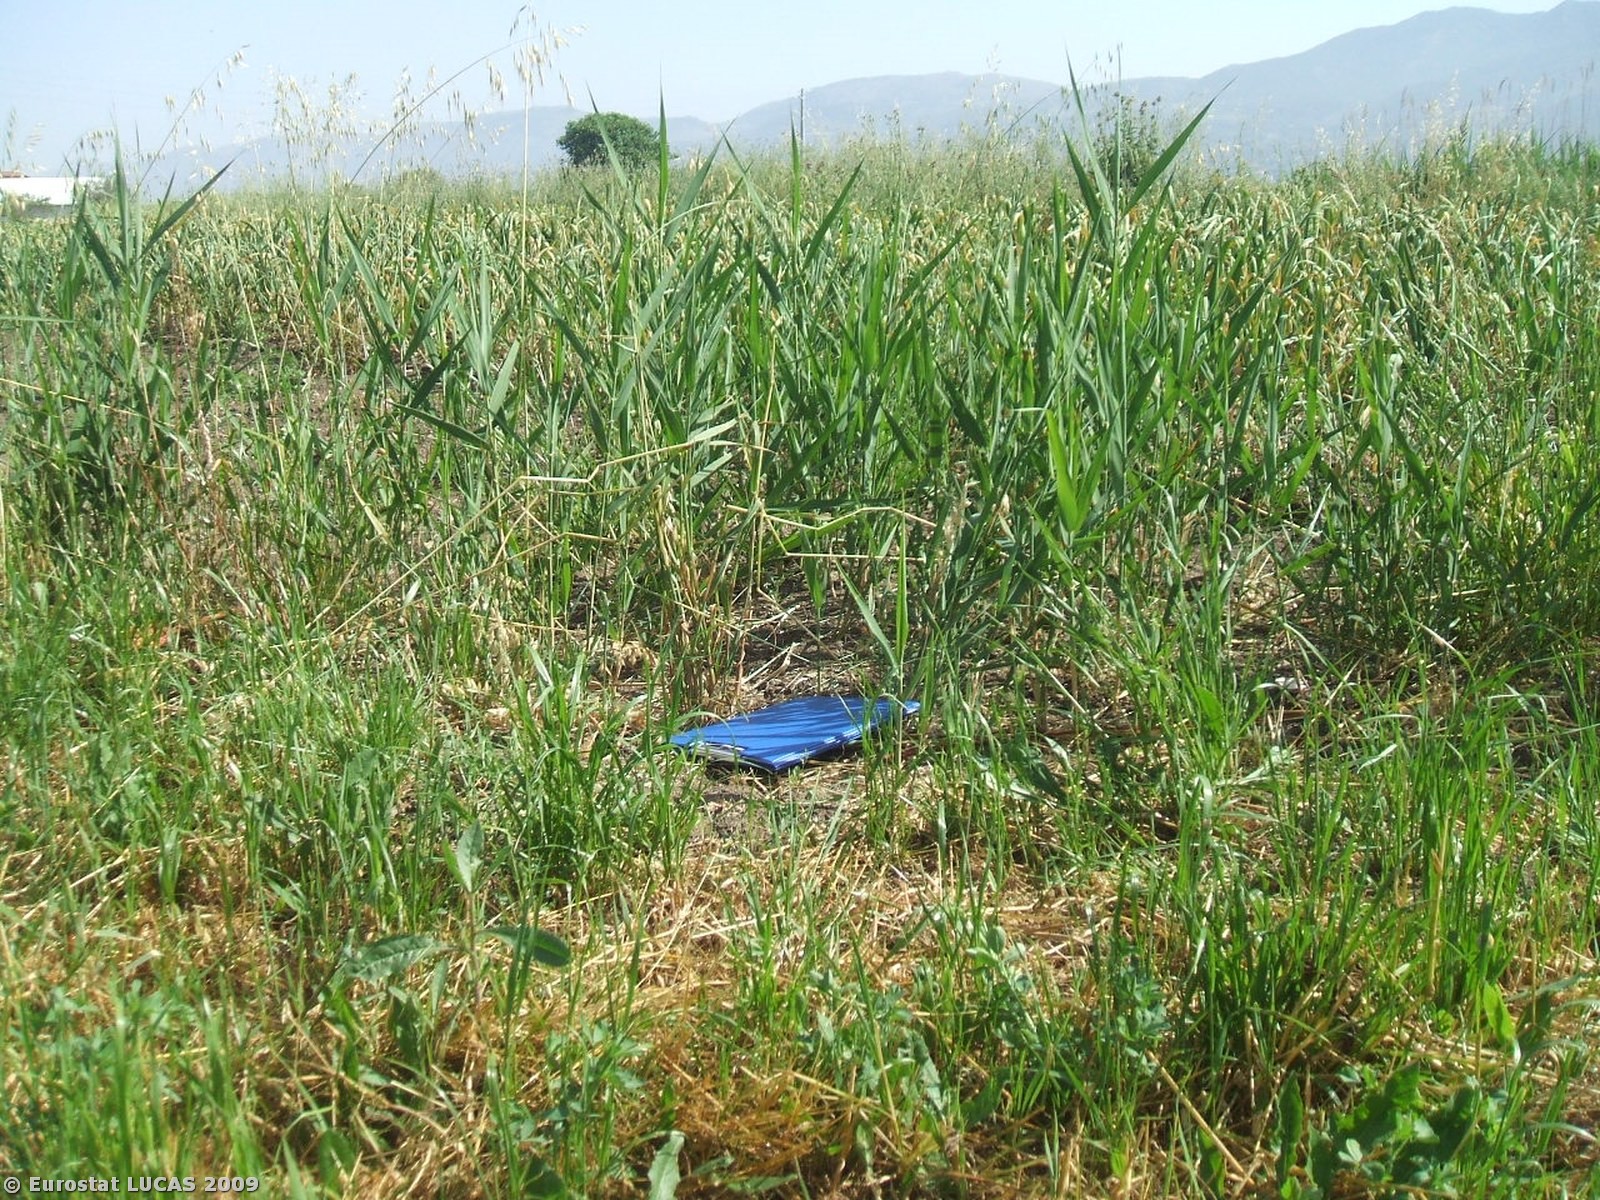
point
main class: Cropland
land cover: Other fresh vegetables
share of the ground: > 75 %
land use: Agriculture (excluding fallow land and kitchen gardens)
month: May
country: IT
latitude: 40.3823
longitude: 15.5484
